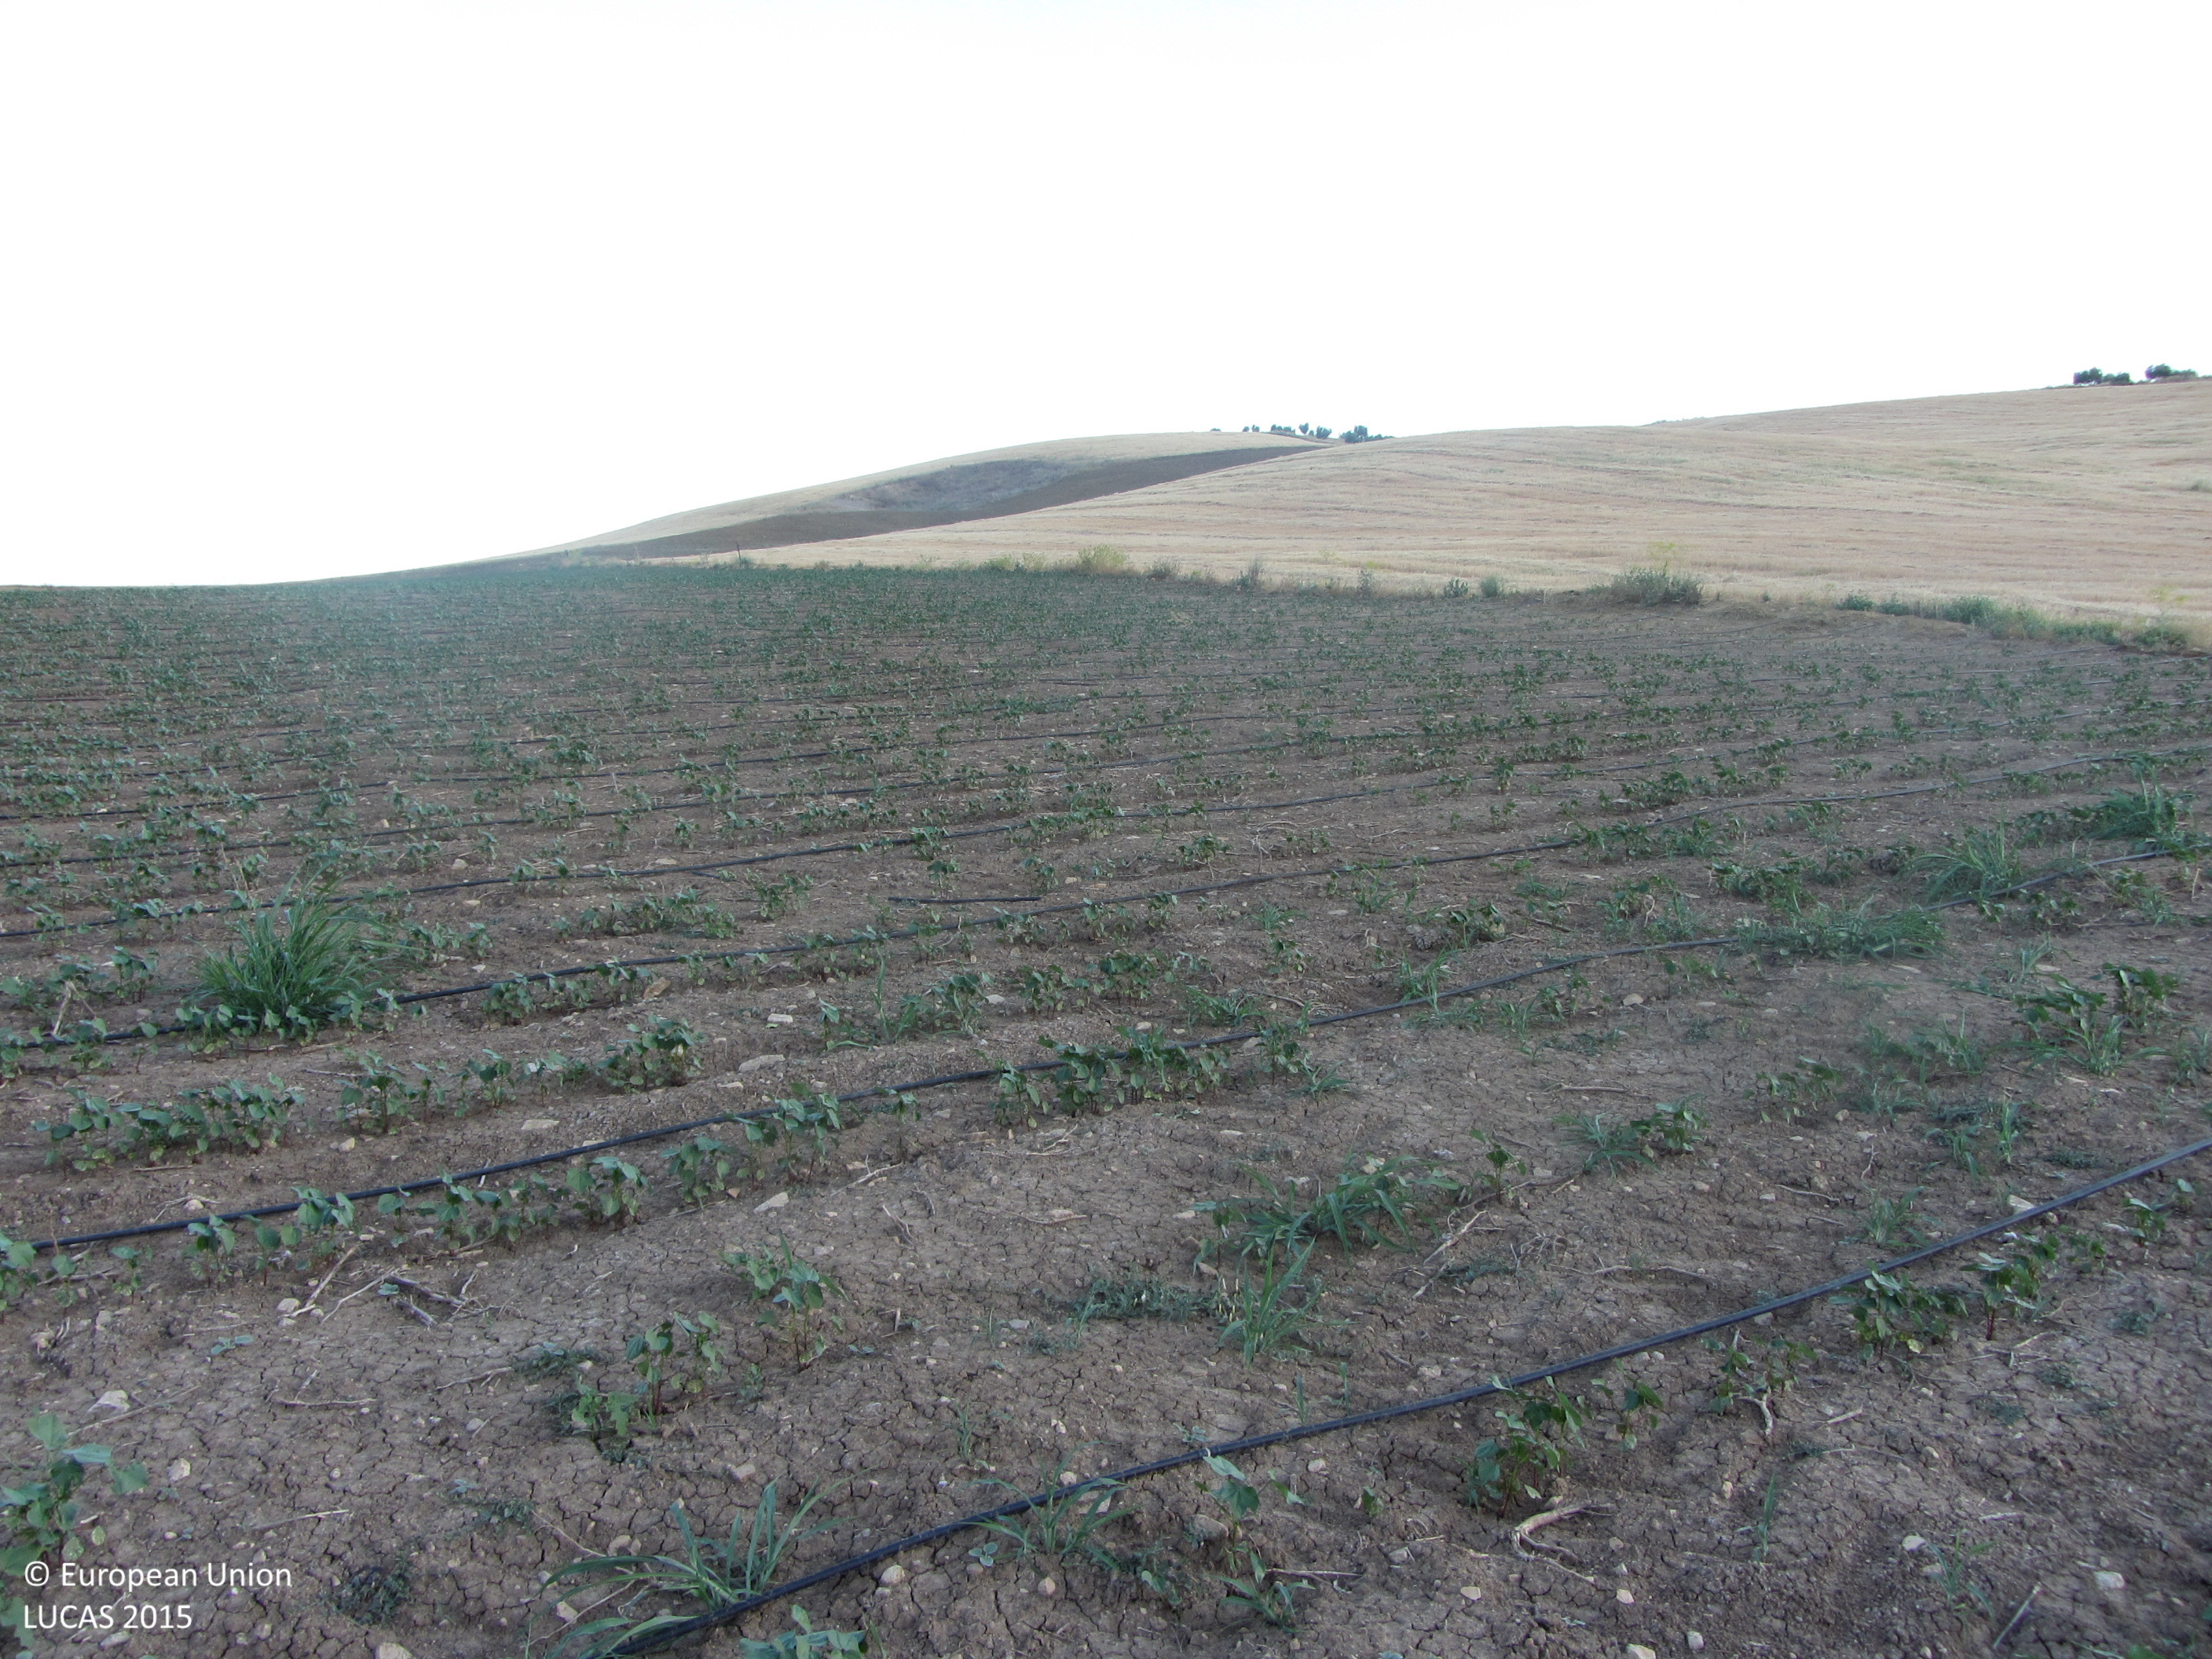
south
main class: Cropland
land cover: Cotton
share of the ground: < 10 %
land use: Agriculture (excluding fallow land and kitchen gardens)
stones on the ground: < 10 %
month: June
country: ES
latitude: 37.9292
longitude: -3.8036
